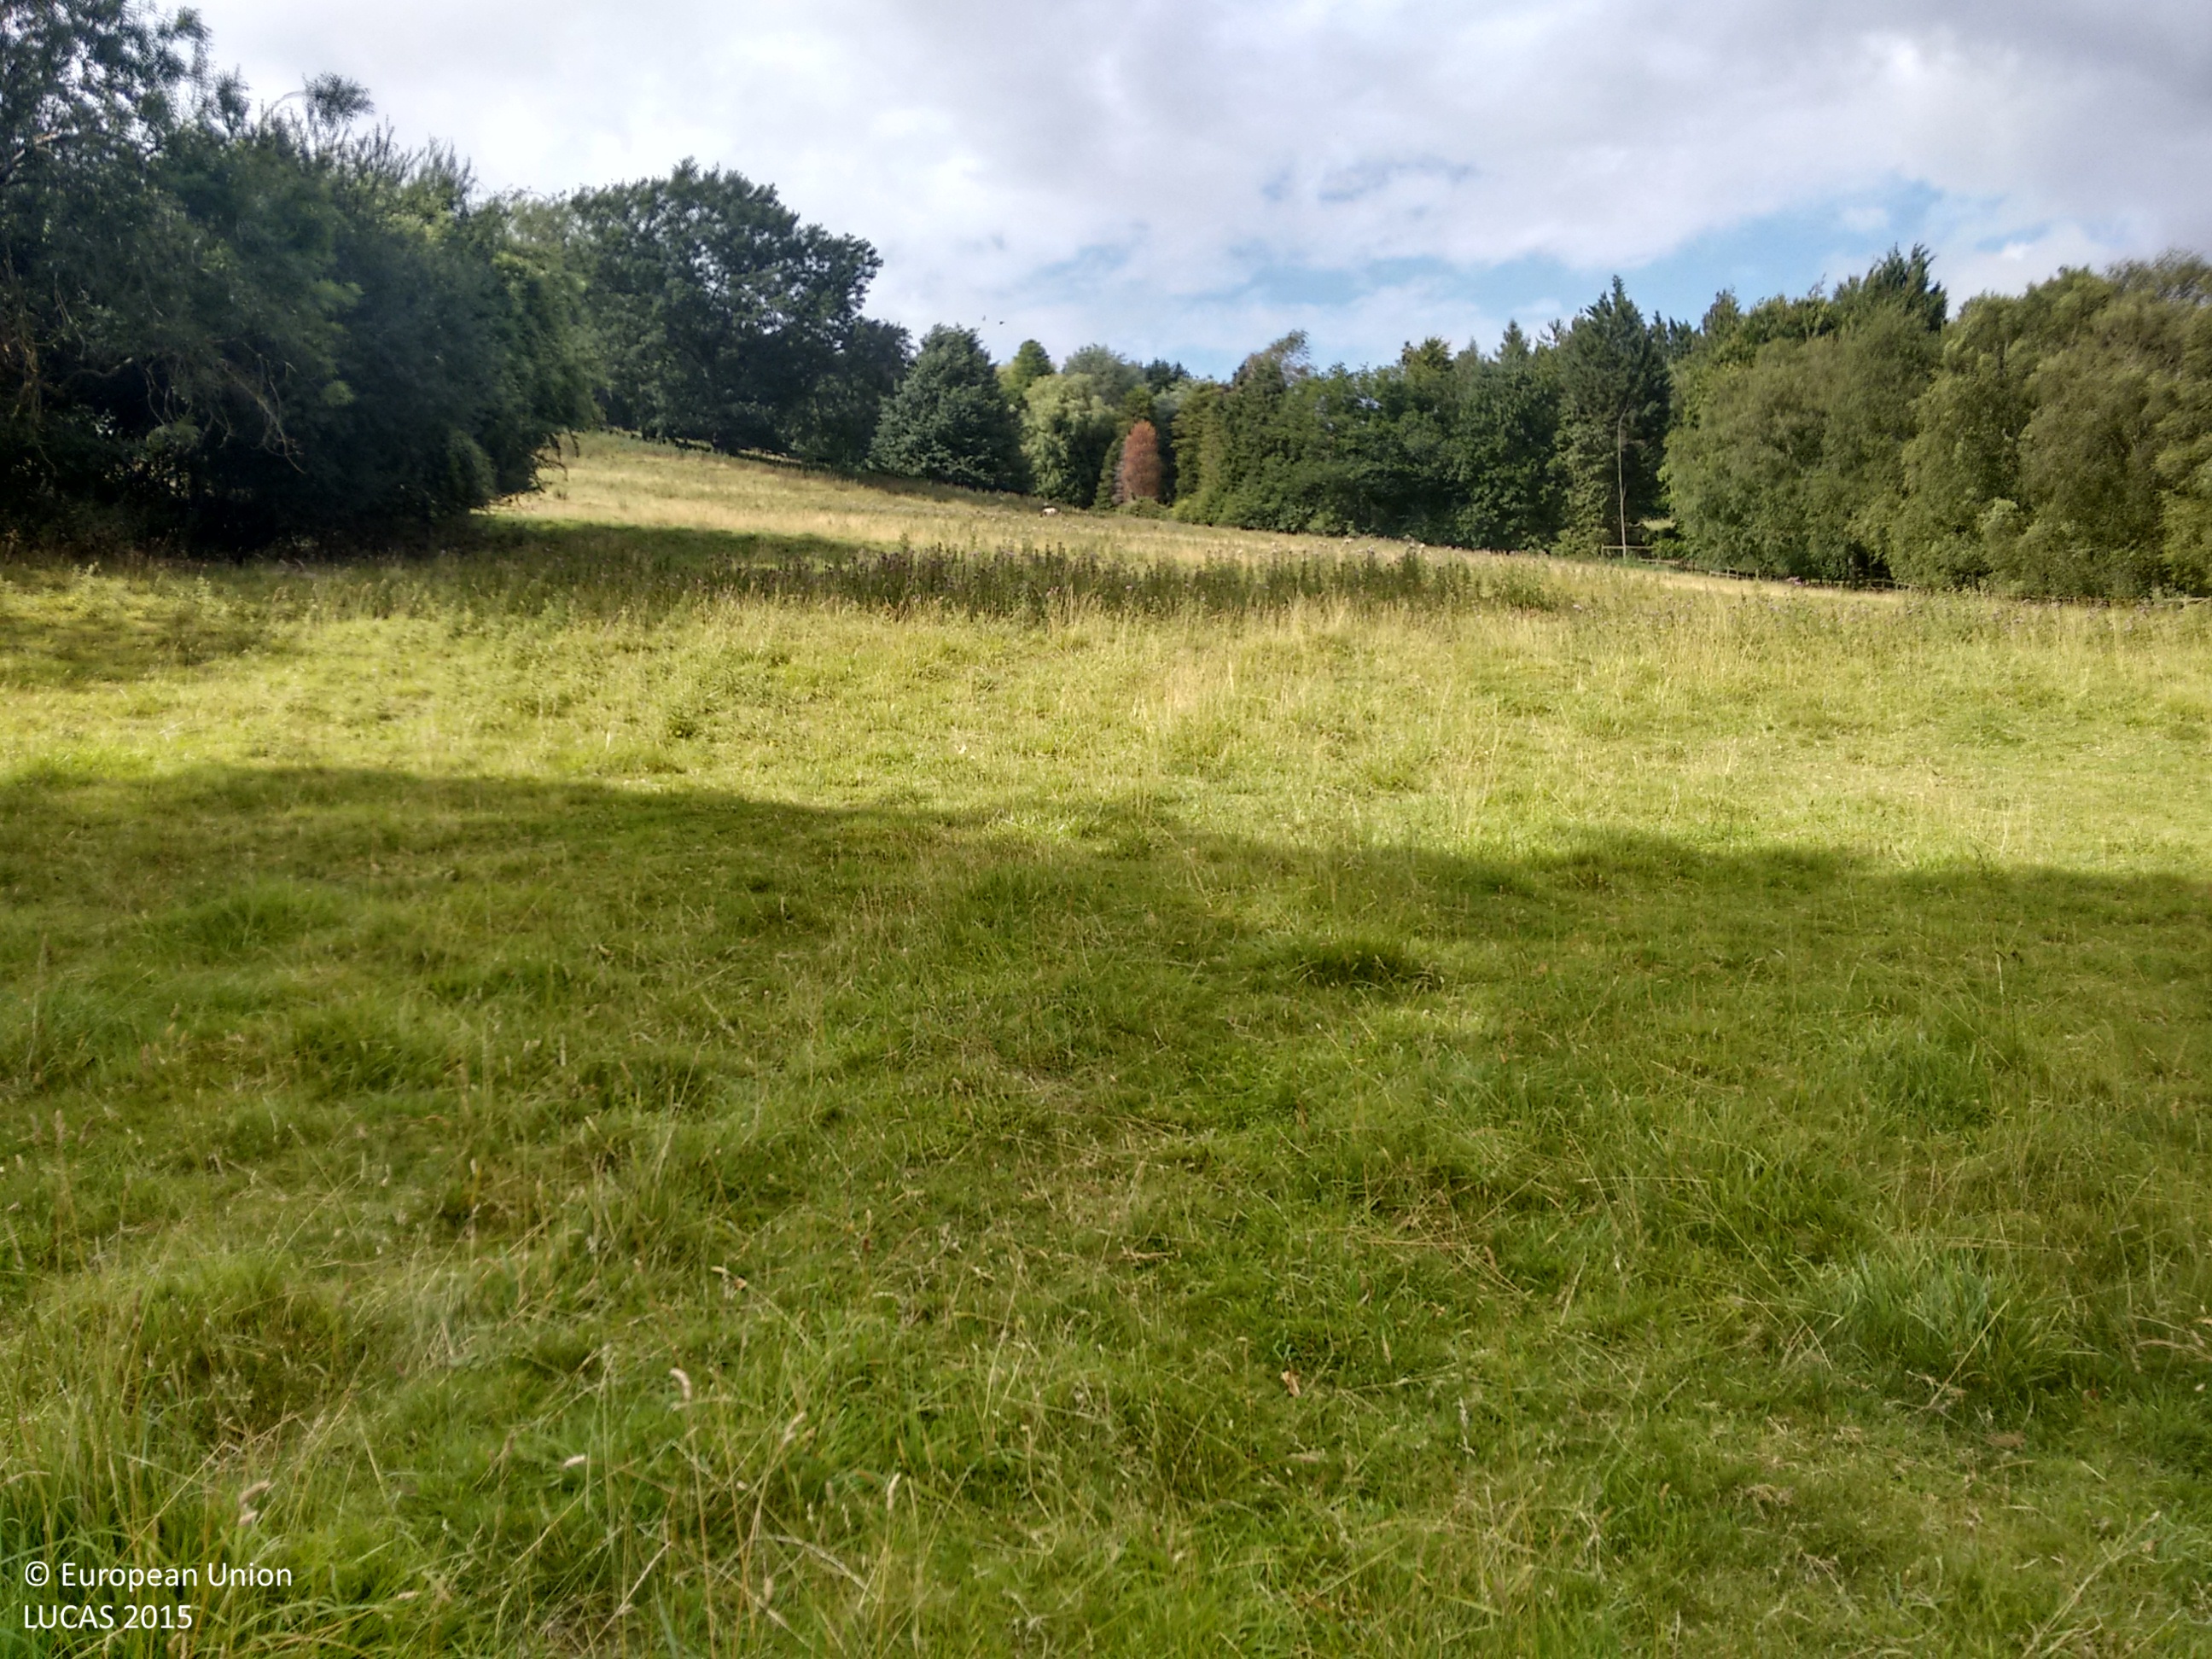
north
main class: Grassland
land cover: Grassland without tree/shrub cover
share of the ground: > 75 %
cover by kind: herbaceous plants 100 %
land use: Agriculture (excluding fallow land and kitchen gardens)
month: July
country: GB
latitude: 51.3955
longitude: -2.4110
